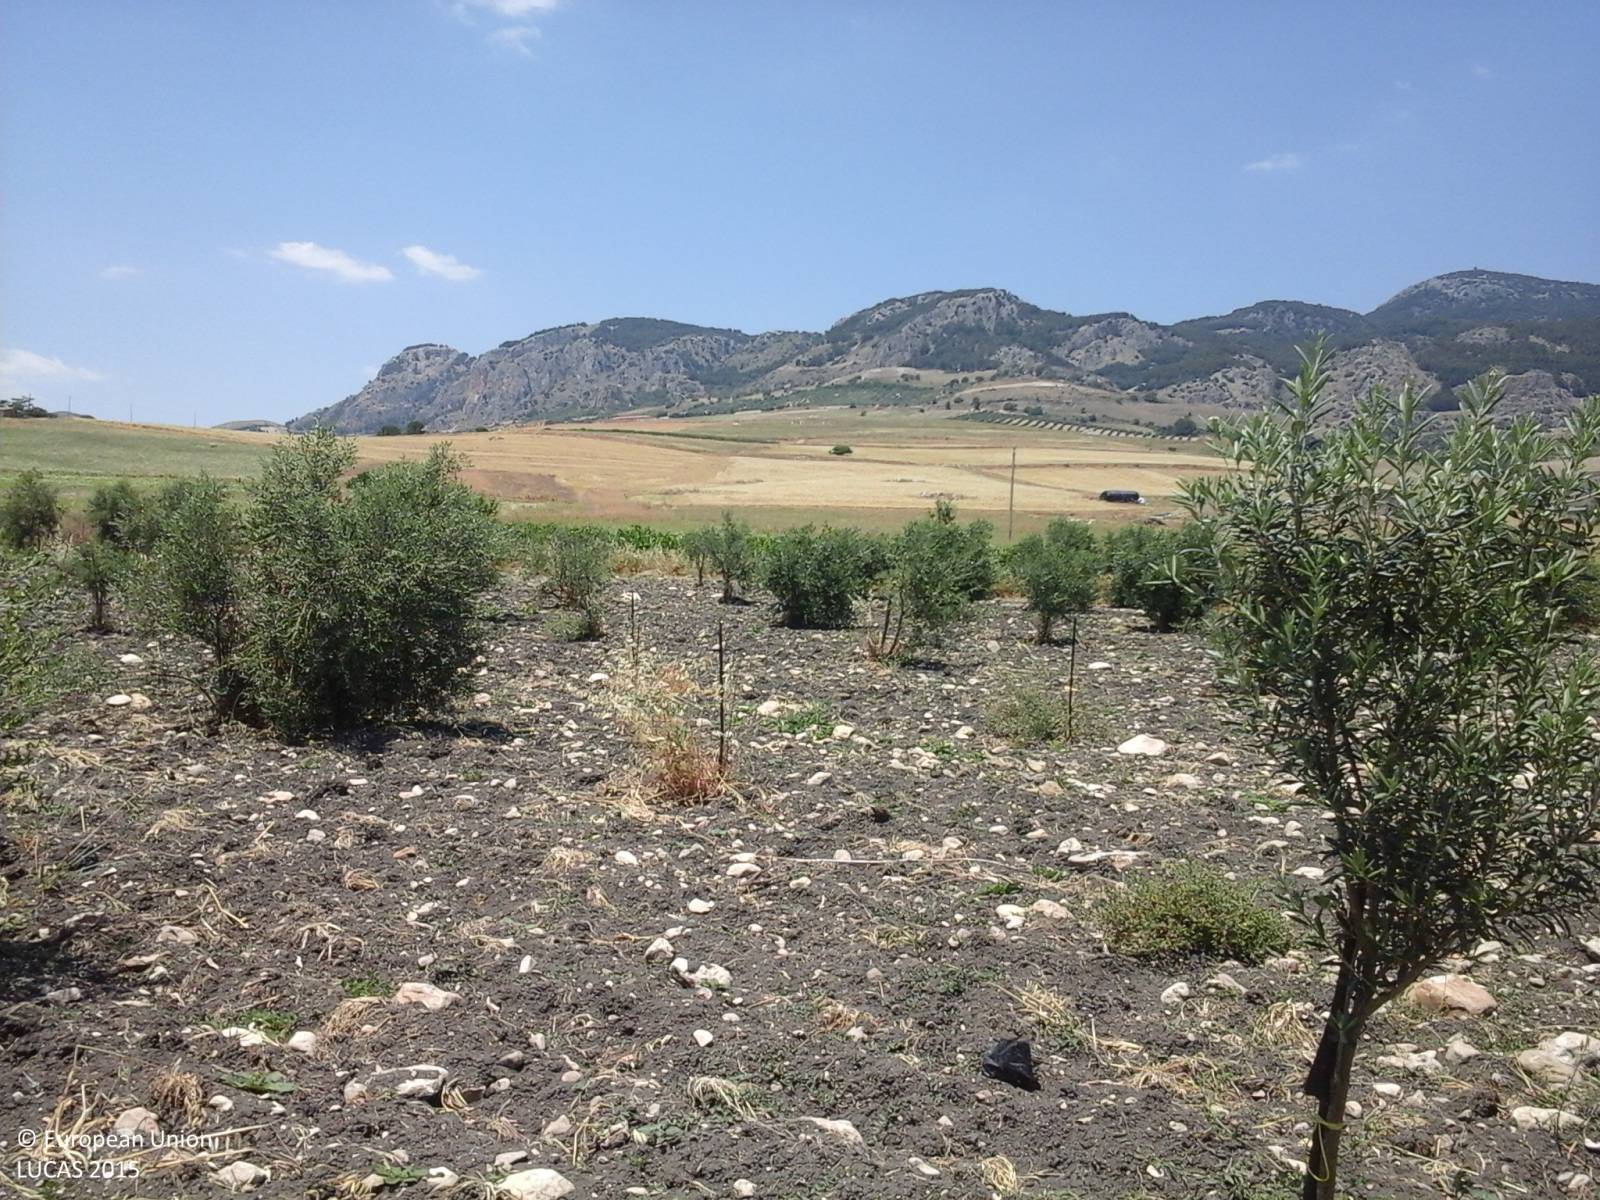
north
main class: Cropland
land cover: Olive groves
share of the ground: 10 - 25 %
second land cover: Other bare soil
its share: > 75 %
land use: Agriculture (excluding fallow land and kitchen gardens)
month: July
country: IT
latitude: 37.6579
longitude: 13.1840
